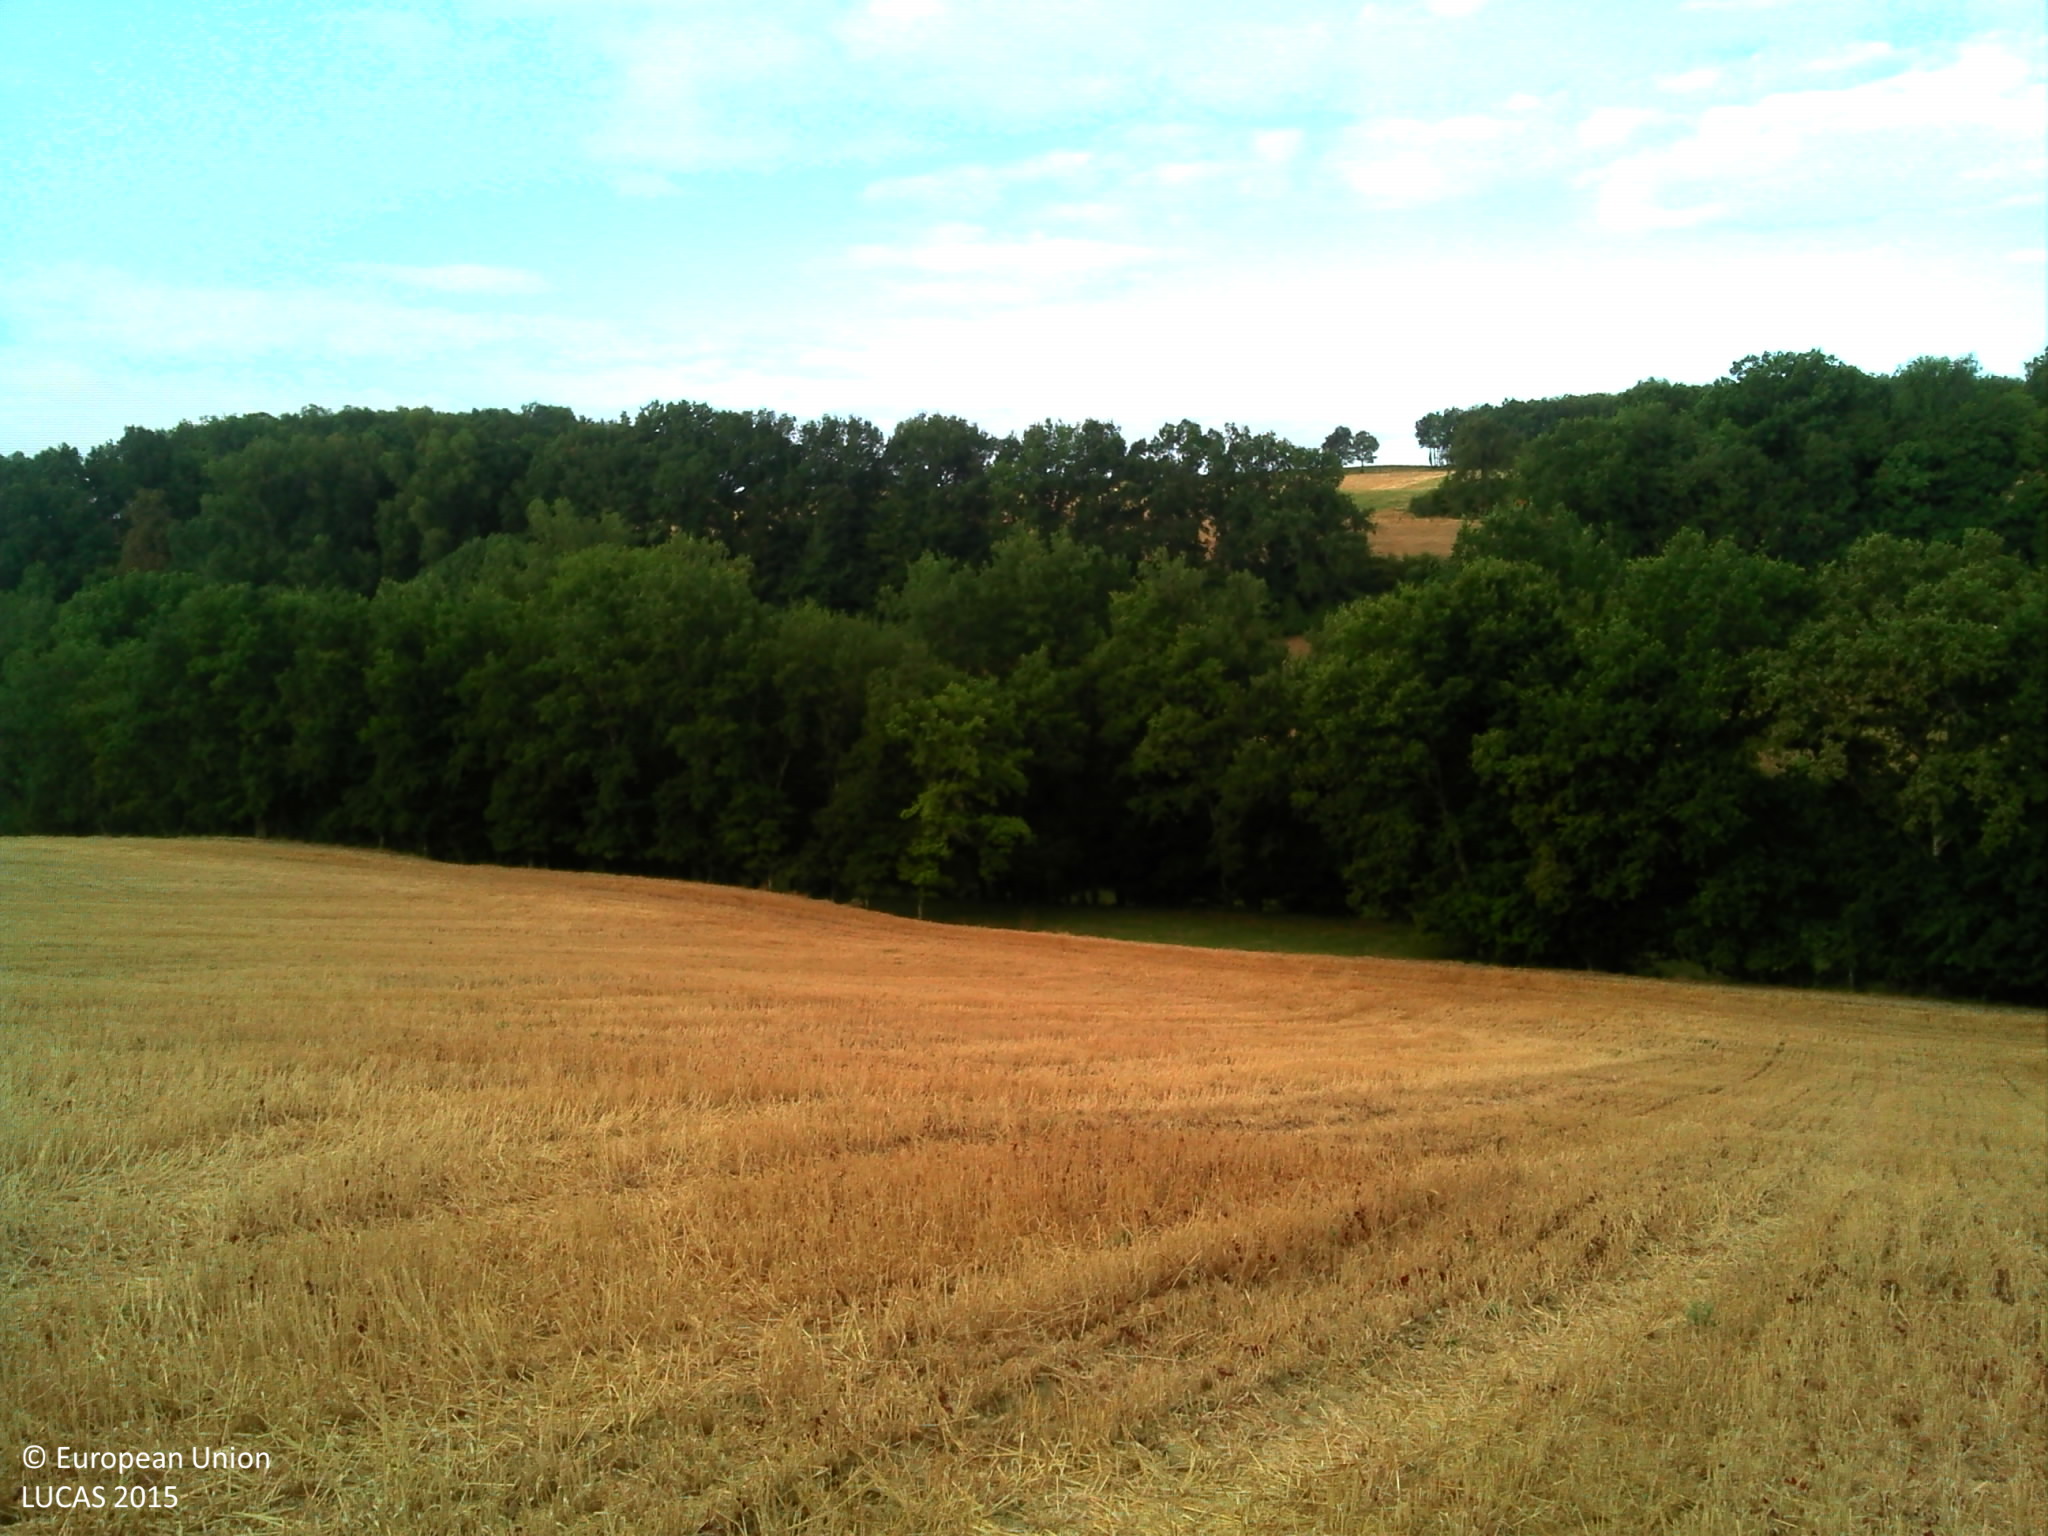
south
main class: Cropland
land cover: Common wheat
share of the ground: > 75 %
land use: Agriculture (excluding fallow land and kitchen gardens)
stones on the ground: < 10 %
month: July
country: FR
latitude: 44.3225
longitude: 0.6022
